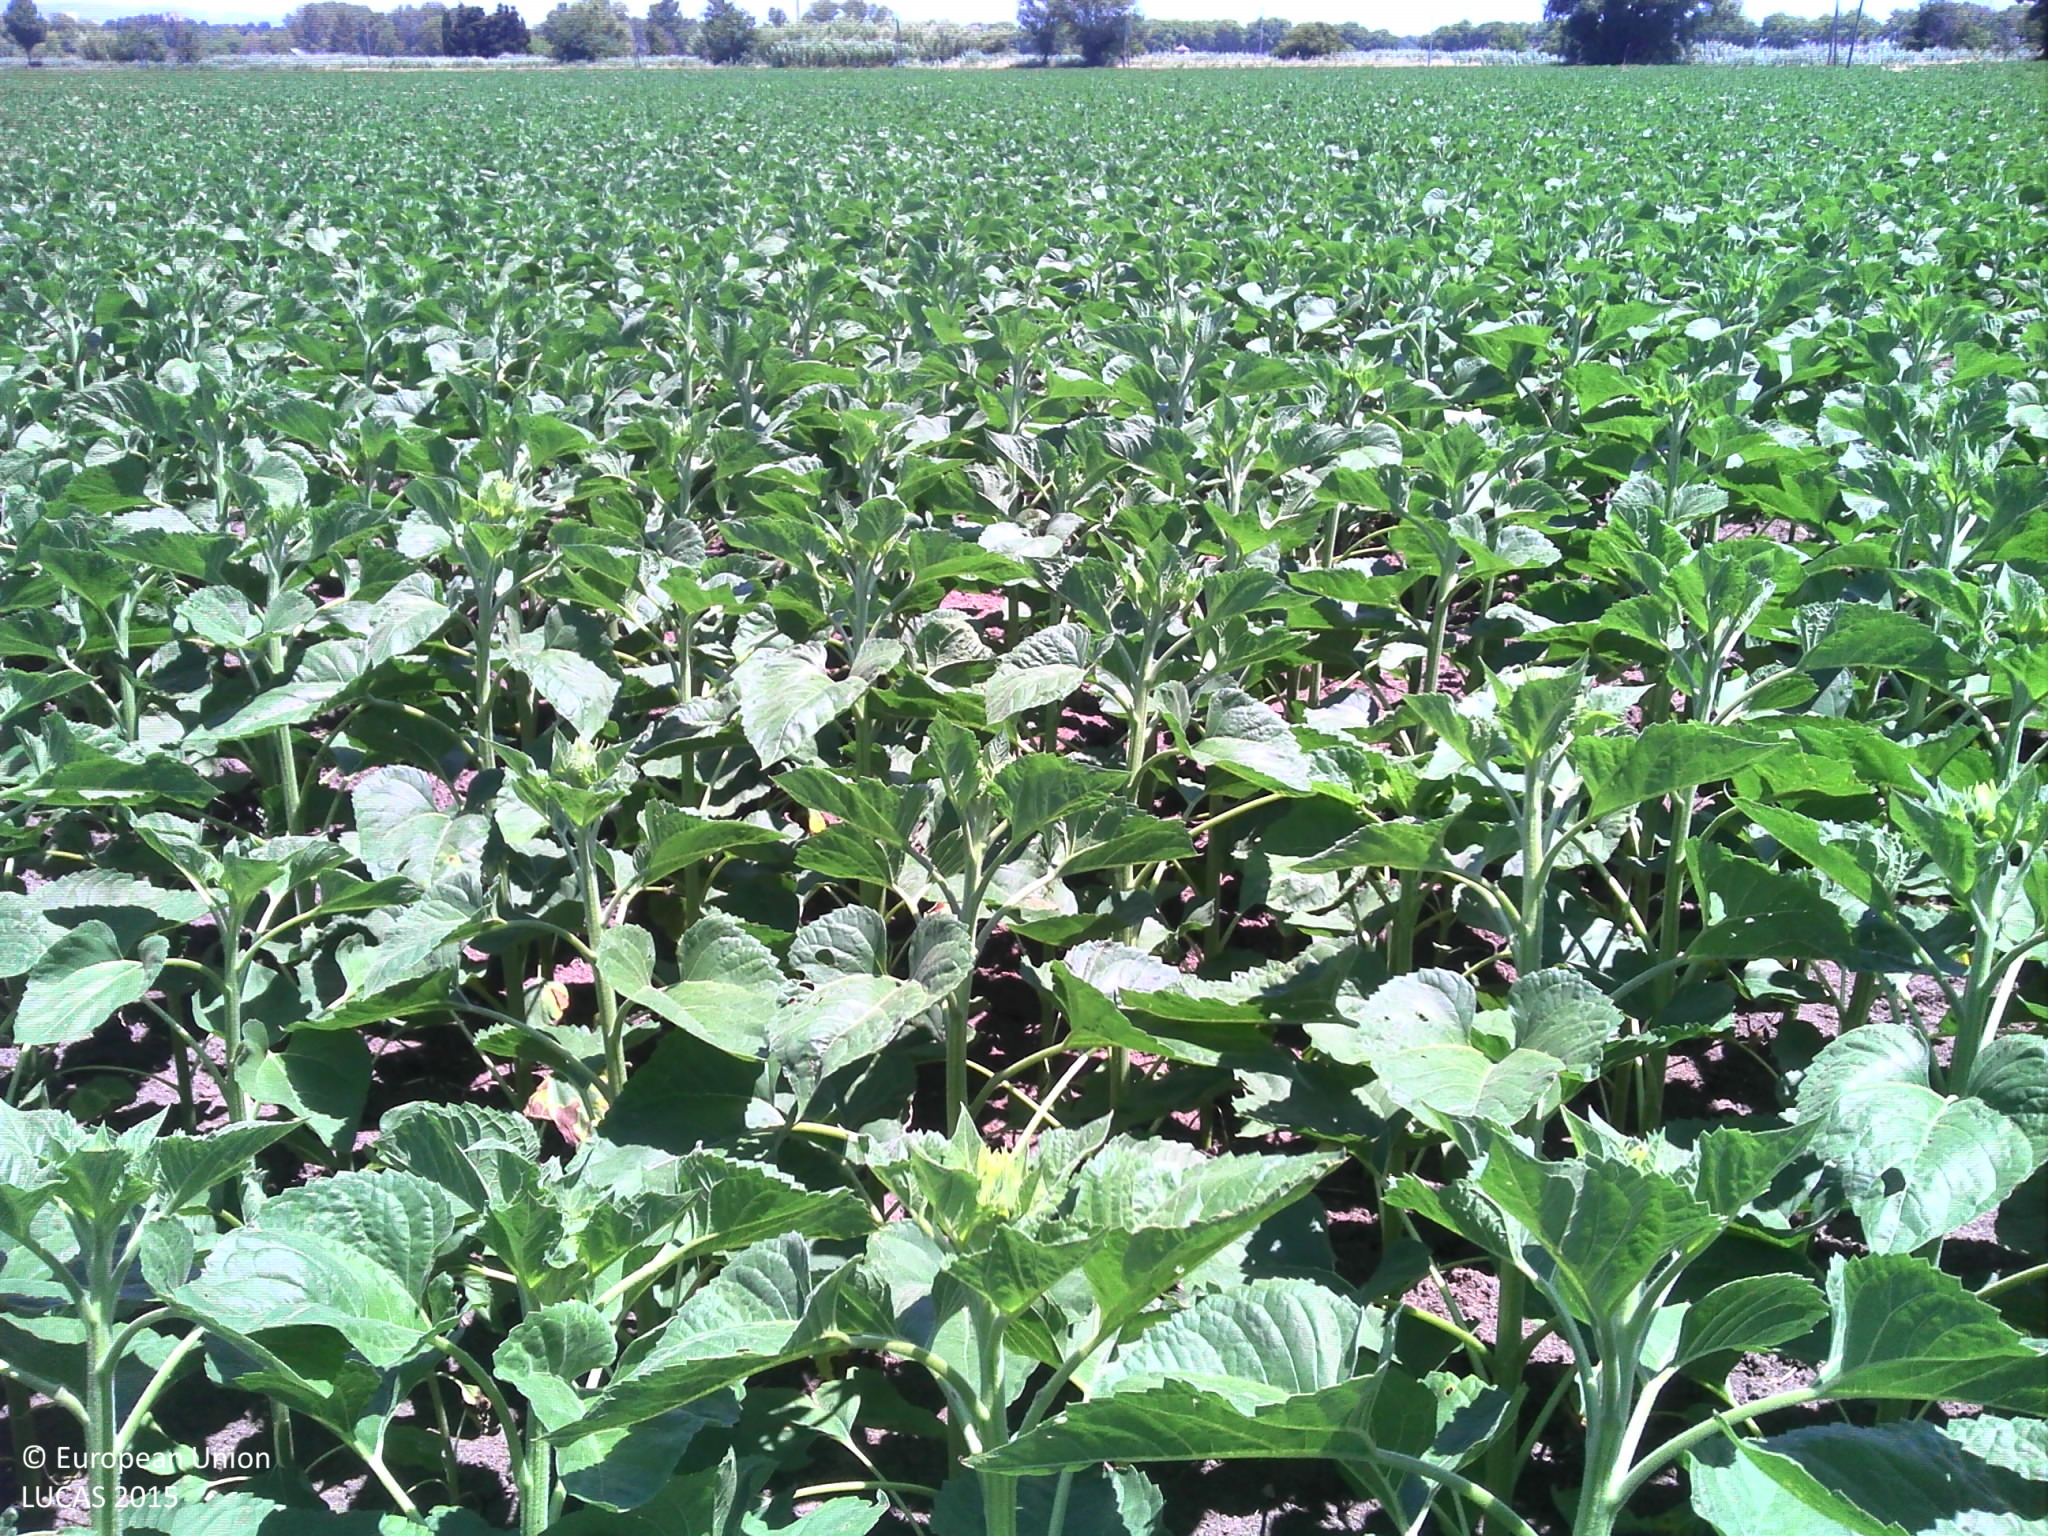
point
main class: Cropland
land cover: Sunflower
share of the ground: > 75 %
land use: Agriculture (excluding fallow land and kitchen gardens)
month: June
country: FR
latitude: 43.2526
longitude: 2.1117
